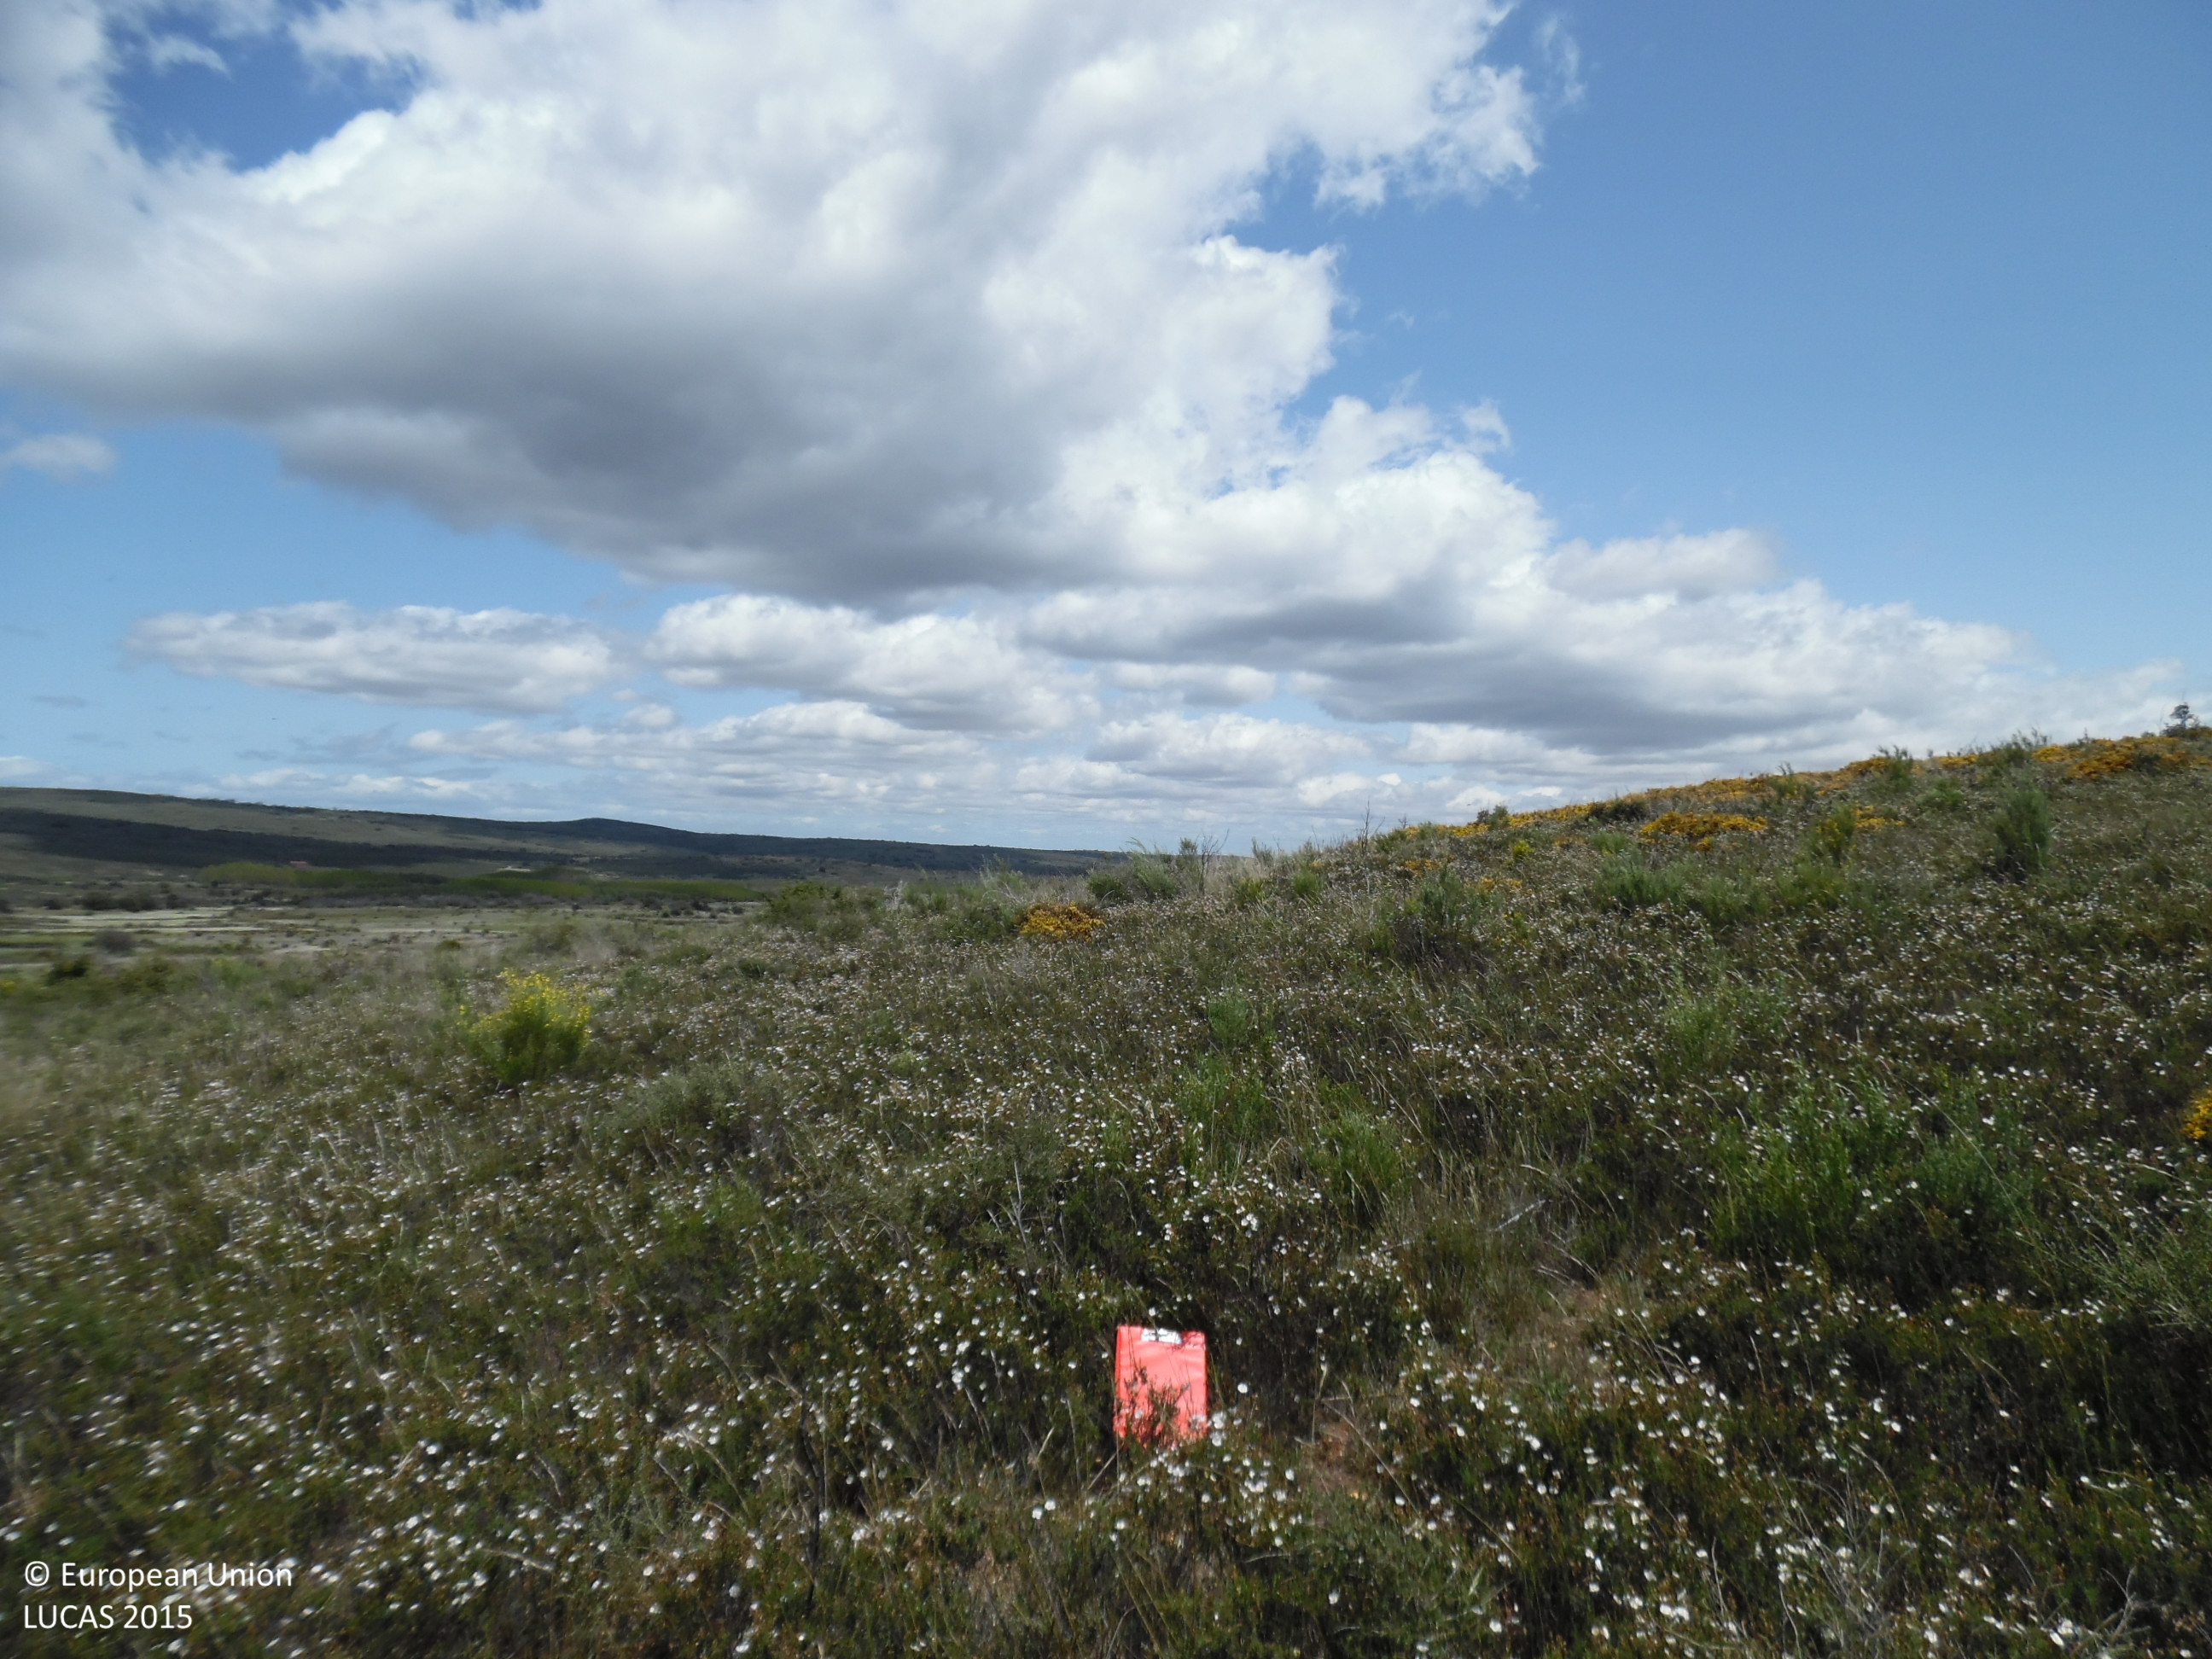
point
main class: Shrubland
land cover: Shrubland without tree cover
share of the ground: > 75 %
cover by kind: shrubs 90 %, herbaceous plants 10 %
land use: Abandoned areas
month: May
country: ES
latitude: 42.3283
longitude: -6.1120
